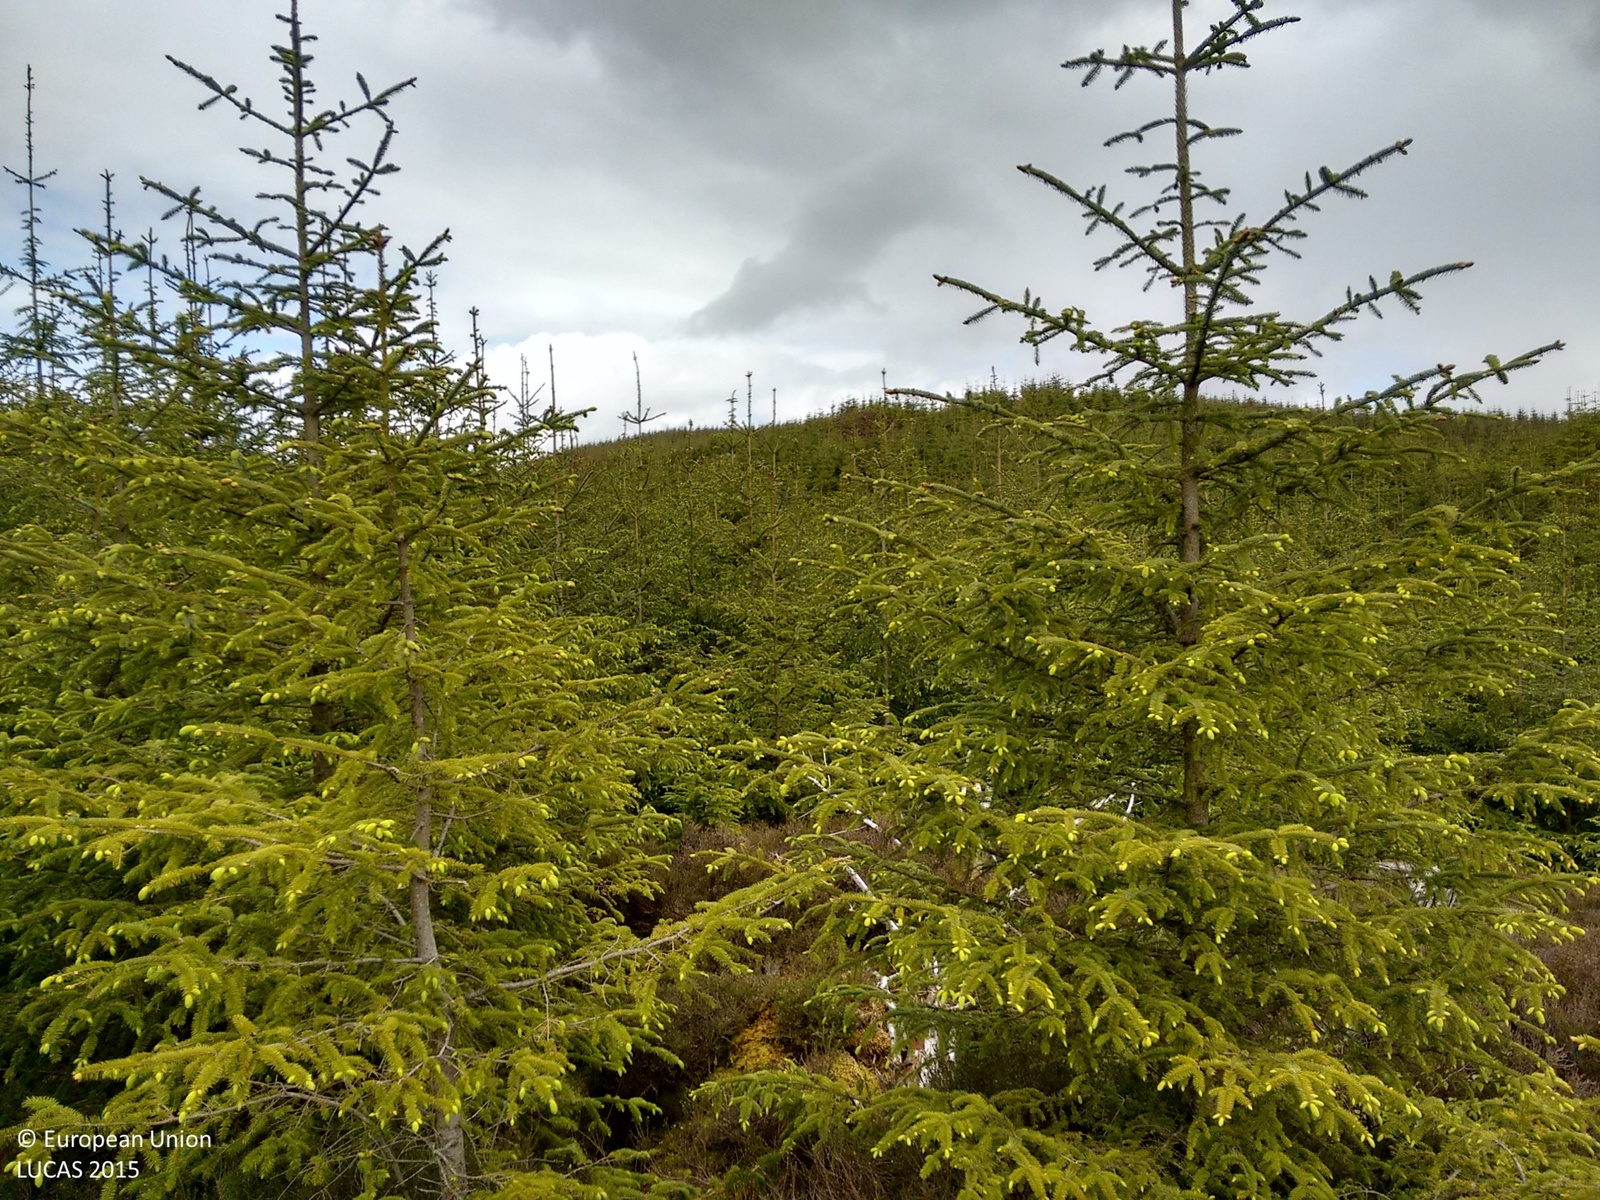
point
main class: Woodland
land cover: Spruce dominated coniferous woodland
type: exotic forest
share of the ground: > 75 %
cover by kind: coniferous forest trees 100 %
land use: Forestry
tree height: > 5 m
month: June
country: GB
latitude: 56.1205
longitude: -5.4825
